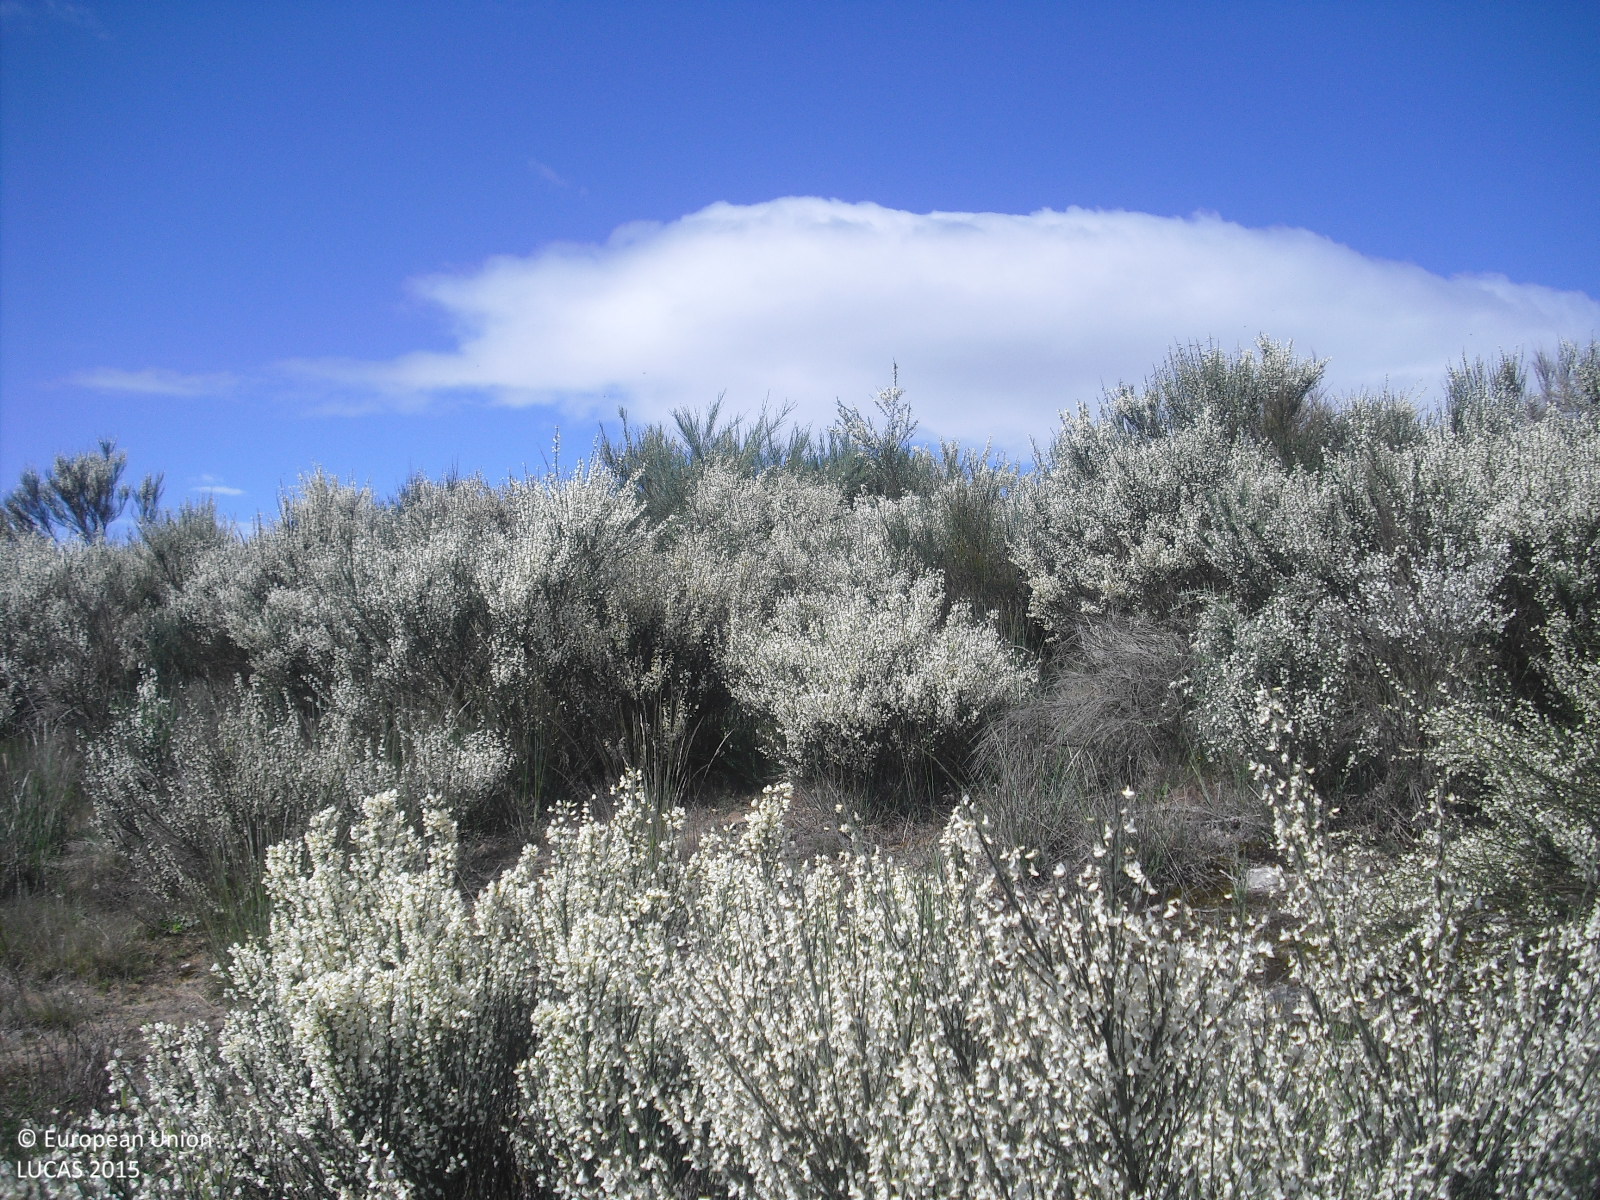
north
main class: Shrubland
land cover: Shrubland with sparse tree cover
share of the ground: 50 - 75 %
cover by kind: shrubs 70 %, herbaceous plants 15 %, consolidated bare surface 10 %, broadleaved forest trees 5 %
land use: Semi-natural and natural areas not in use
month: April
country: ES
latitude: 41.8565
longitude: -7.5894
